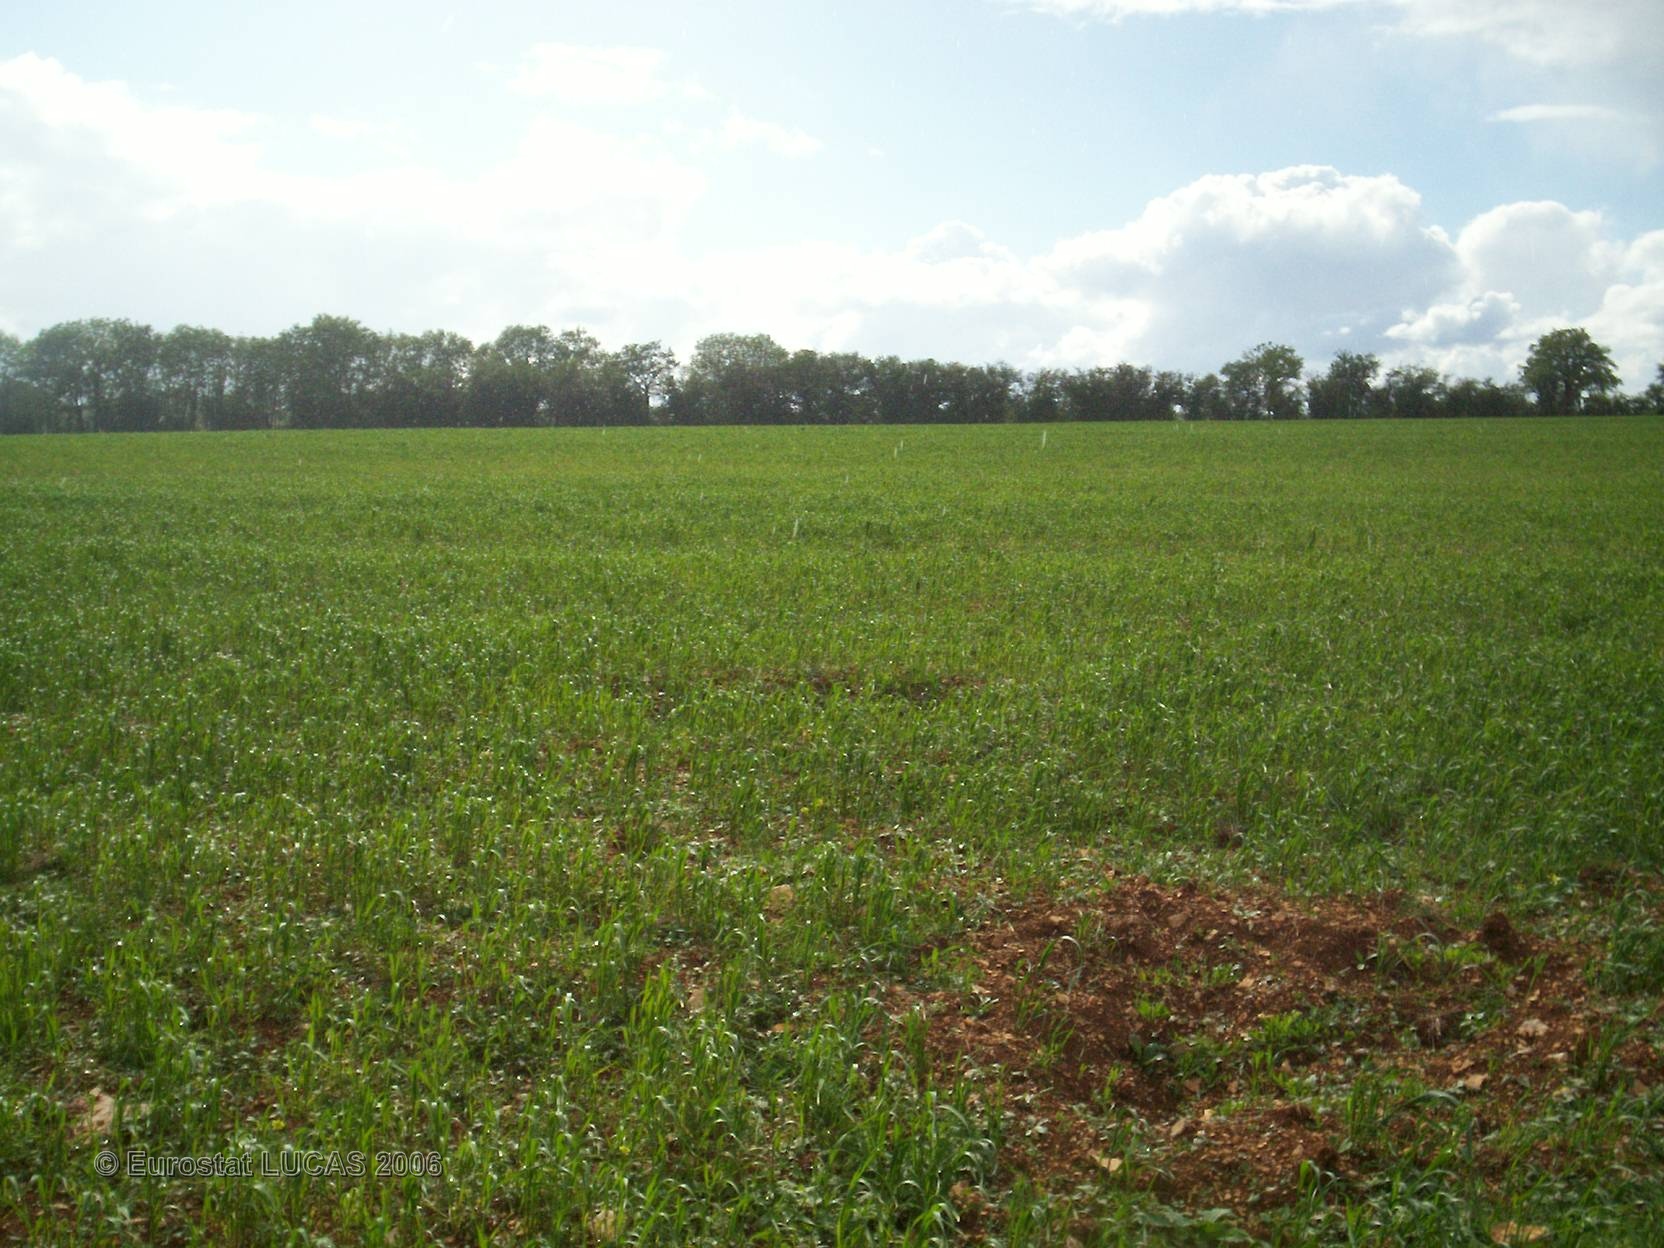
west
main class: Cropland
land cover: Barley
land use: Agriculture (excluding fallow land and kitchen gardens)
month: May
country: FR
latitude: 47.0125
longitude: 4.6730
